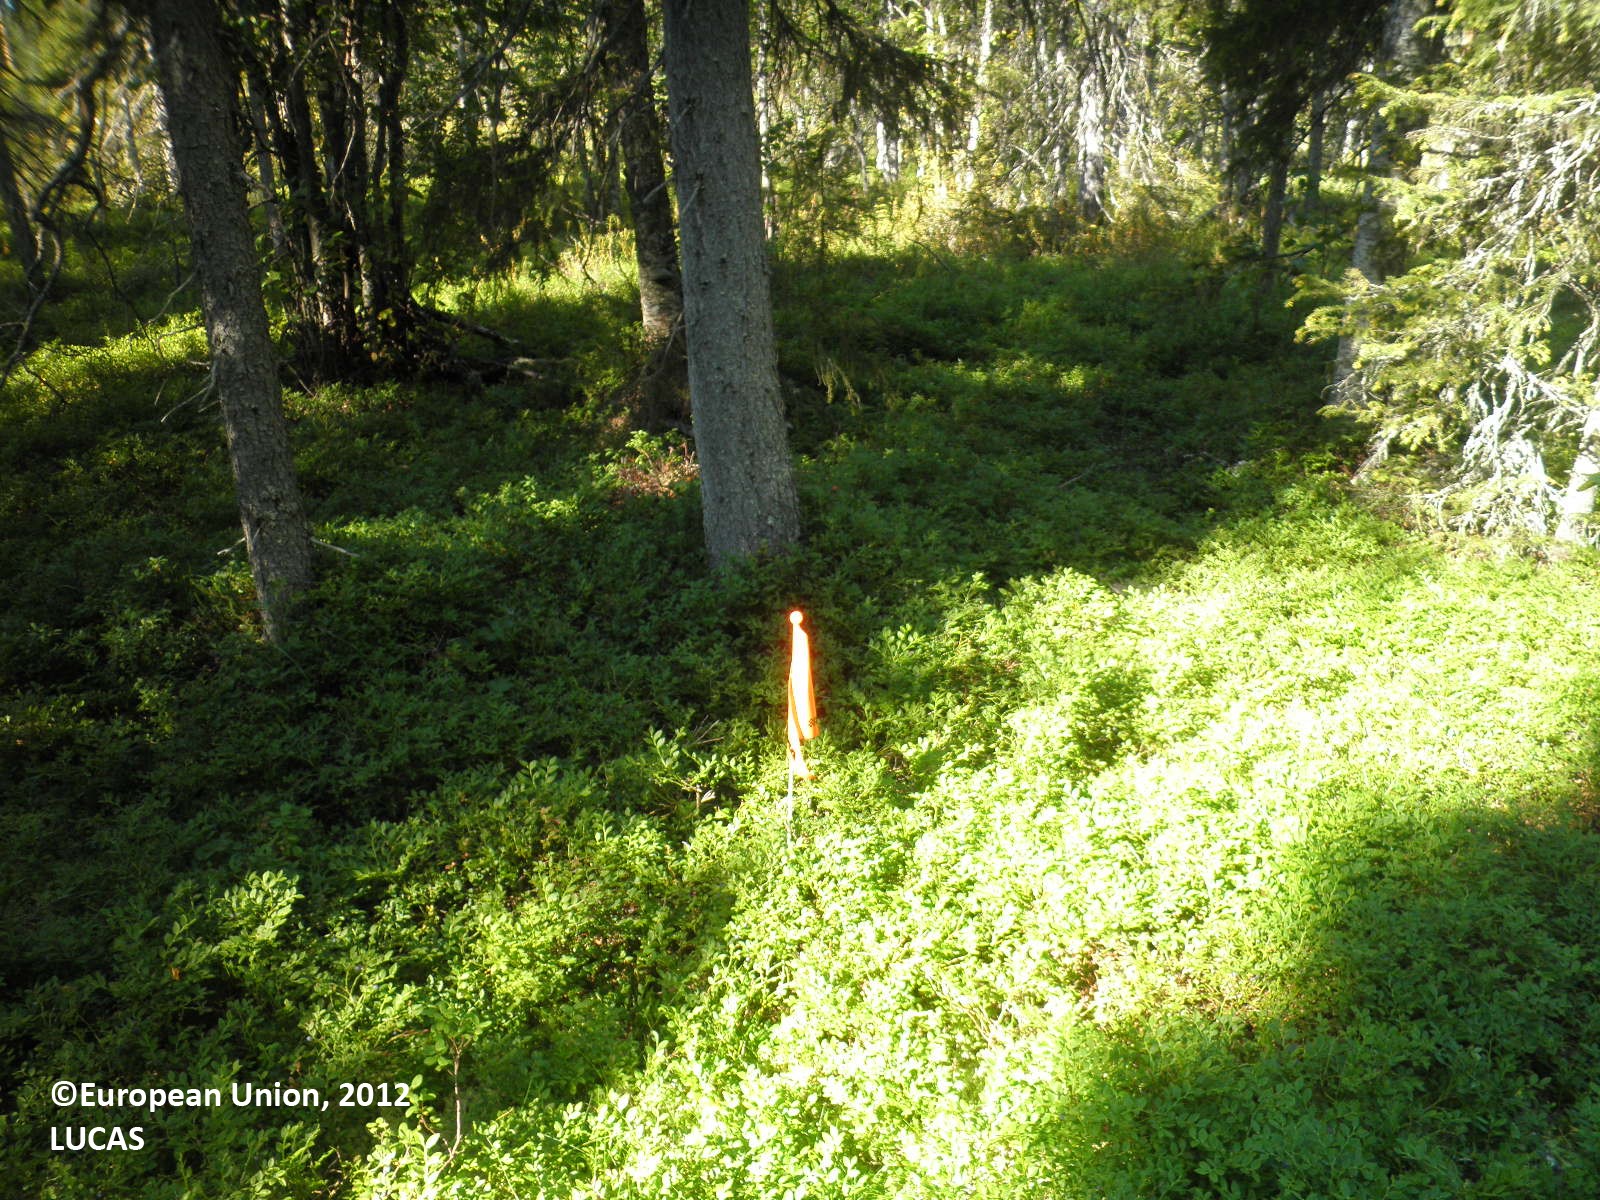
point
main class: Woodland
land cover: Spruce dominated mixed woodland
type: boreal forest
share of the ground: 50 - 75 %
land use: Forestry
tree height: > 5 m
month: August
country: FI
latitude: 67.4881
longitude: 25.8548
